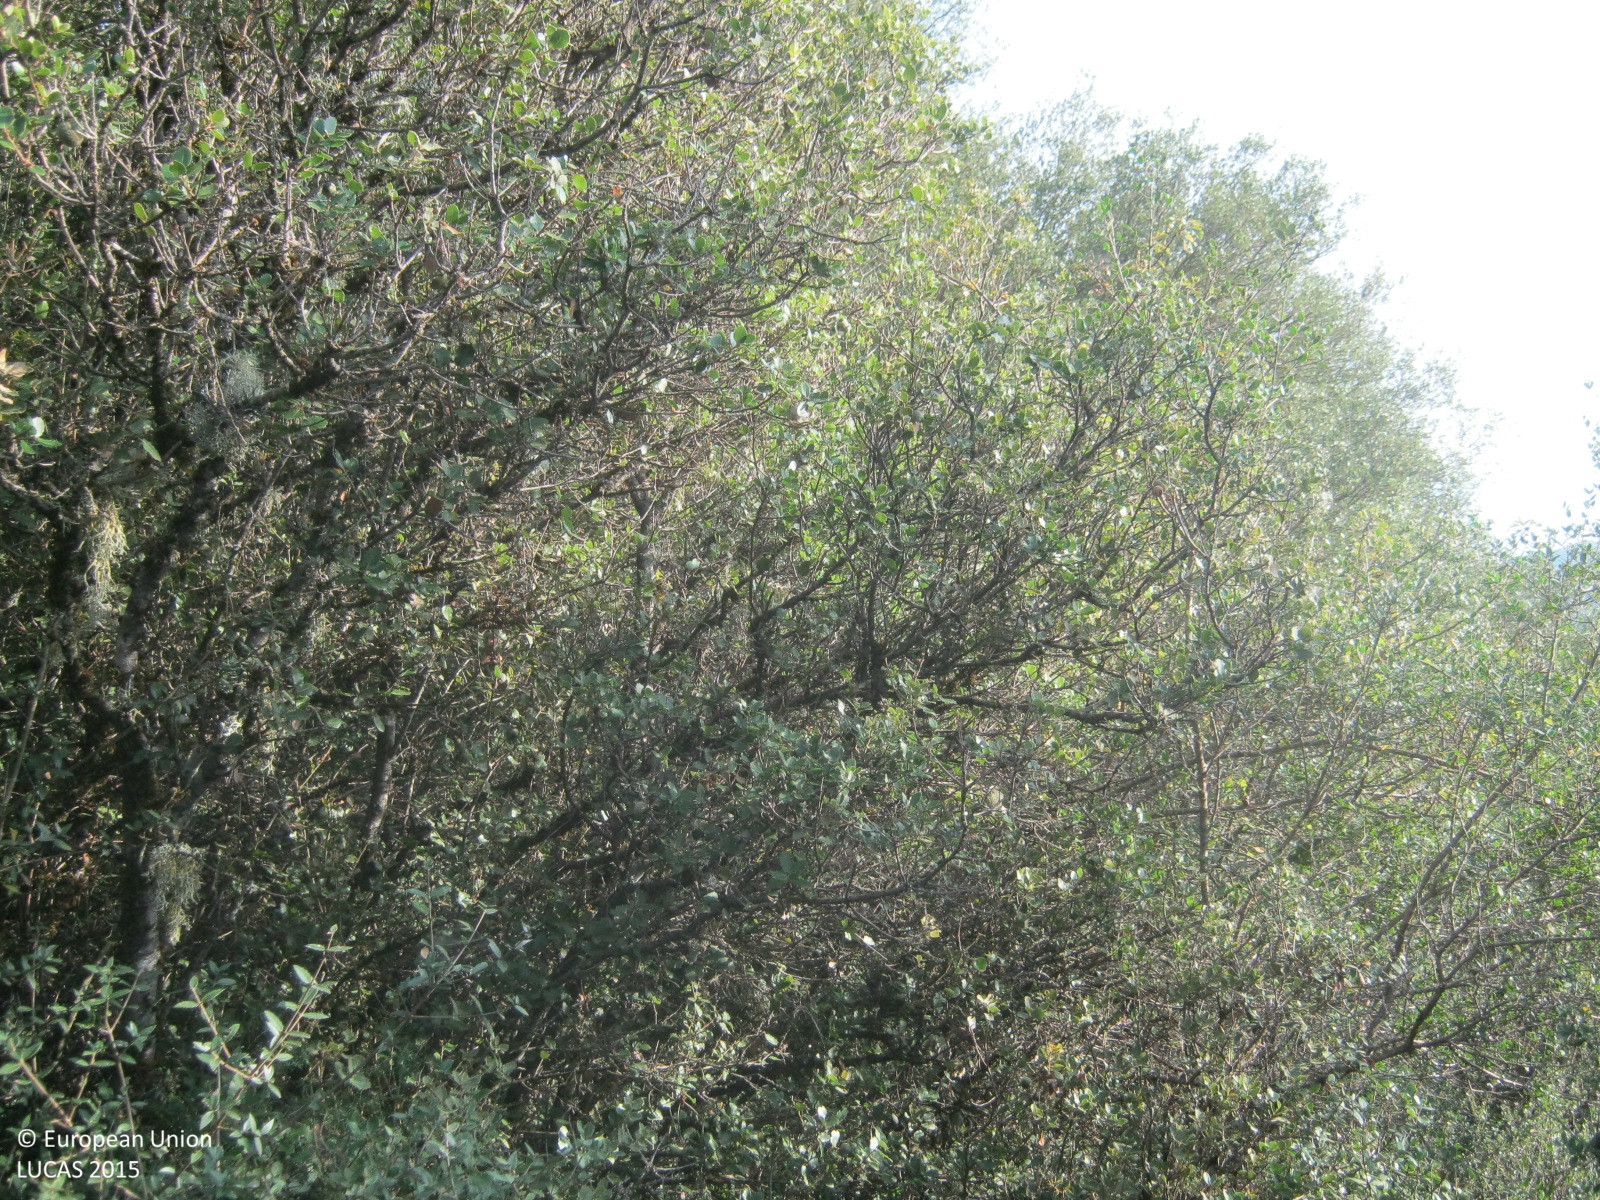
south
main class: Woodland
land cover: Broadleaved woodland
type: broadleaved evergreen forest
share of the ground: > 75 %
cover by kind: broadleaved forest trees 75 %, shrubs 20 %, herbaceous plants 5 %
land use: Semi-natural and natural areas not in use
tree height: < 5 m
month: September
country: GR
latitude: 37.9179
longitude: 22.1488
